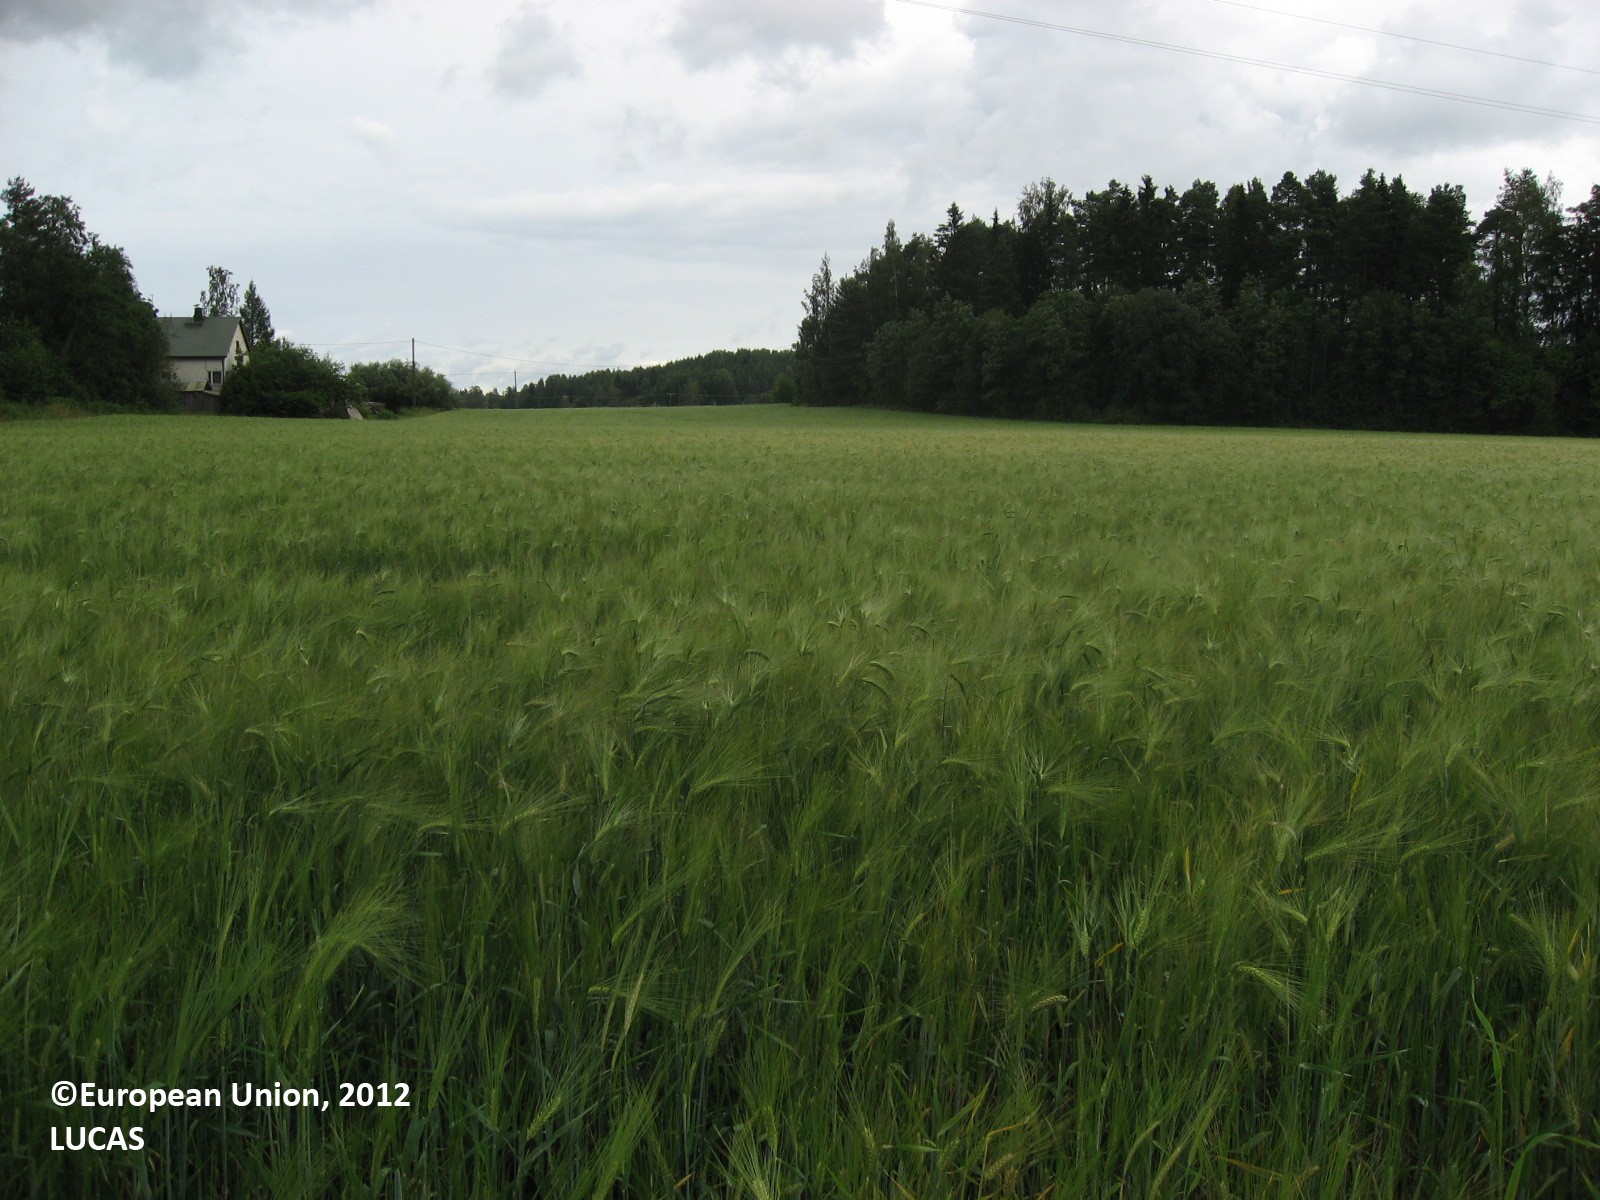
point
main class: Cropland
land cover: Barley
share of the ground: > 75 %
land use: Agriculture (excluding fallow land and kitchen gardens)
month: July
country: FI
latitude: 61.0682
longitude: 25.6384
